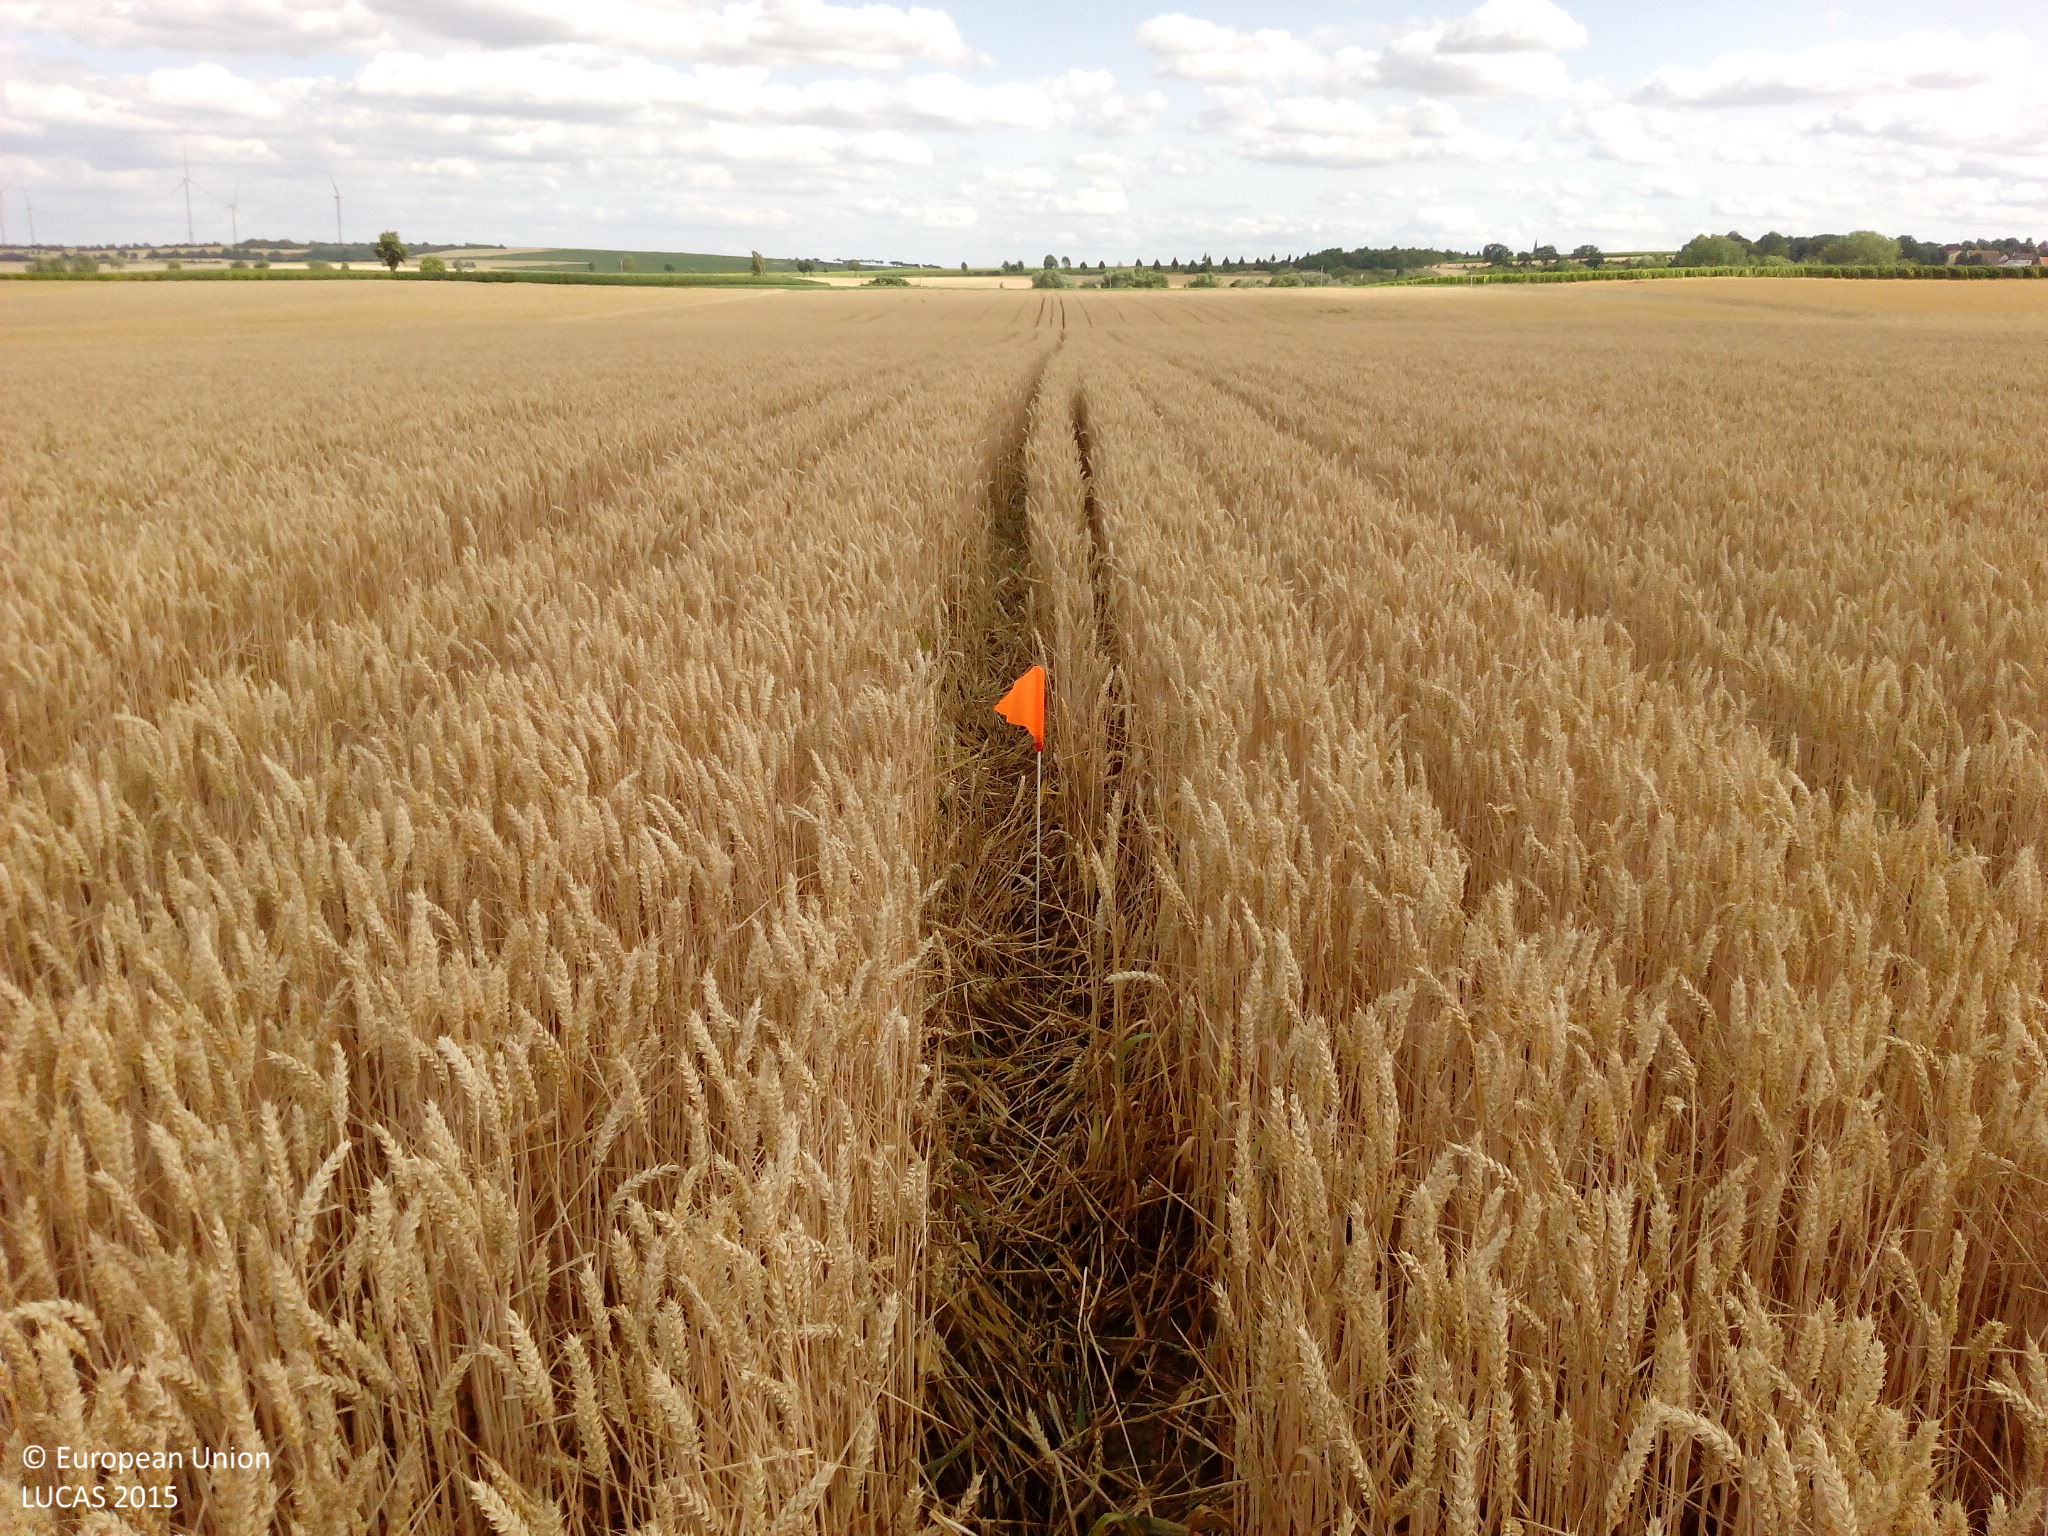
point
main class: Cropland
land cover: Common wheat
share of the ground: > 75 %
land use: Agriculture (excluding fallow land and kitchen gardens)
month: July
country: DE
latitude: 49.7017
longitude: 8.1564
